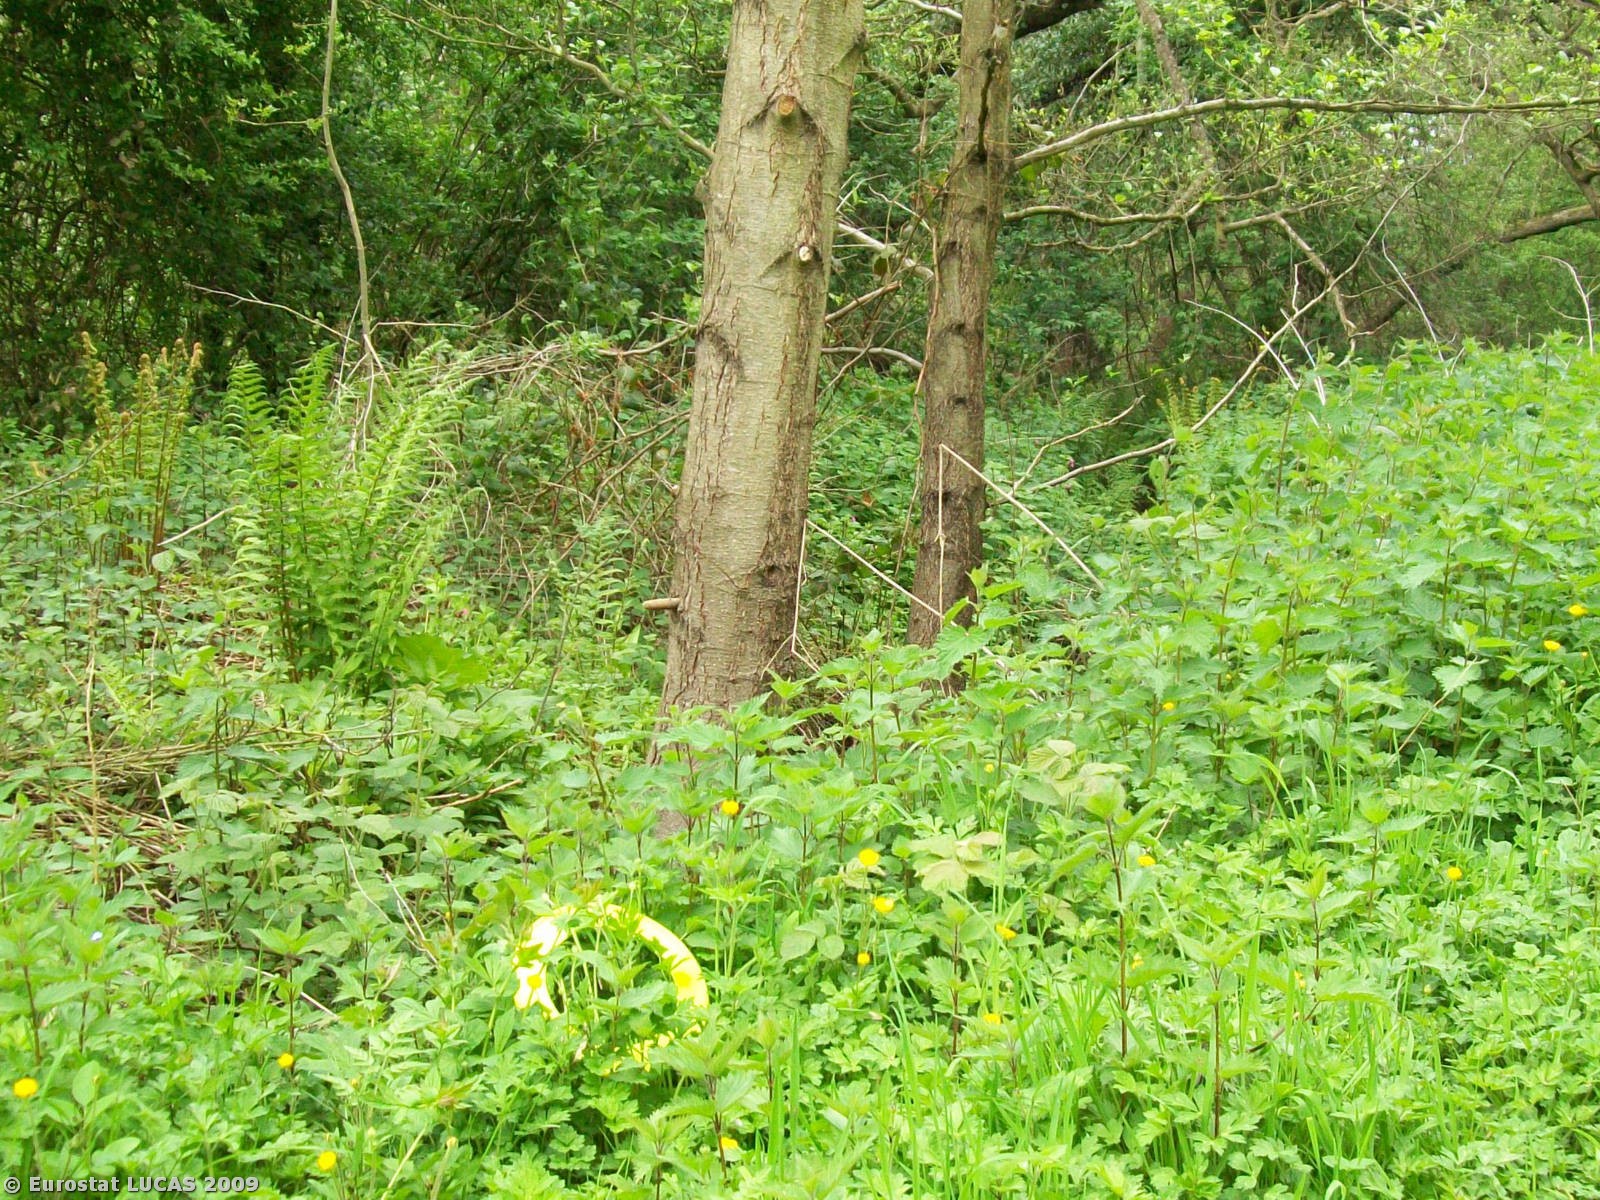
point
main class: Woodland
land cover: Broadleaved woodland
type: mesophytic deciduous forest
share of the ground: 25 - 50 %
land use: Unused
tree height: > 5 m
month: May
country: GB
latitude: 52.3359
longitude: -2.4671
